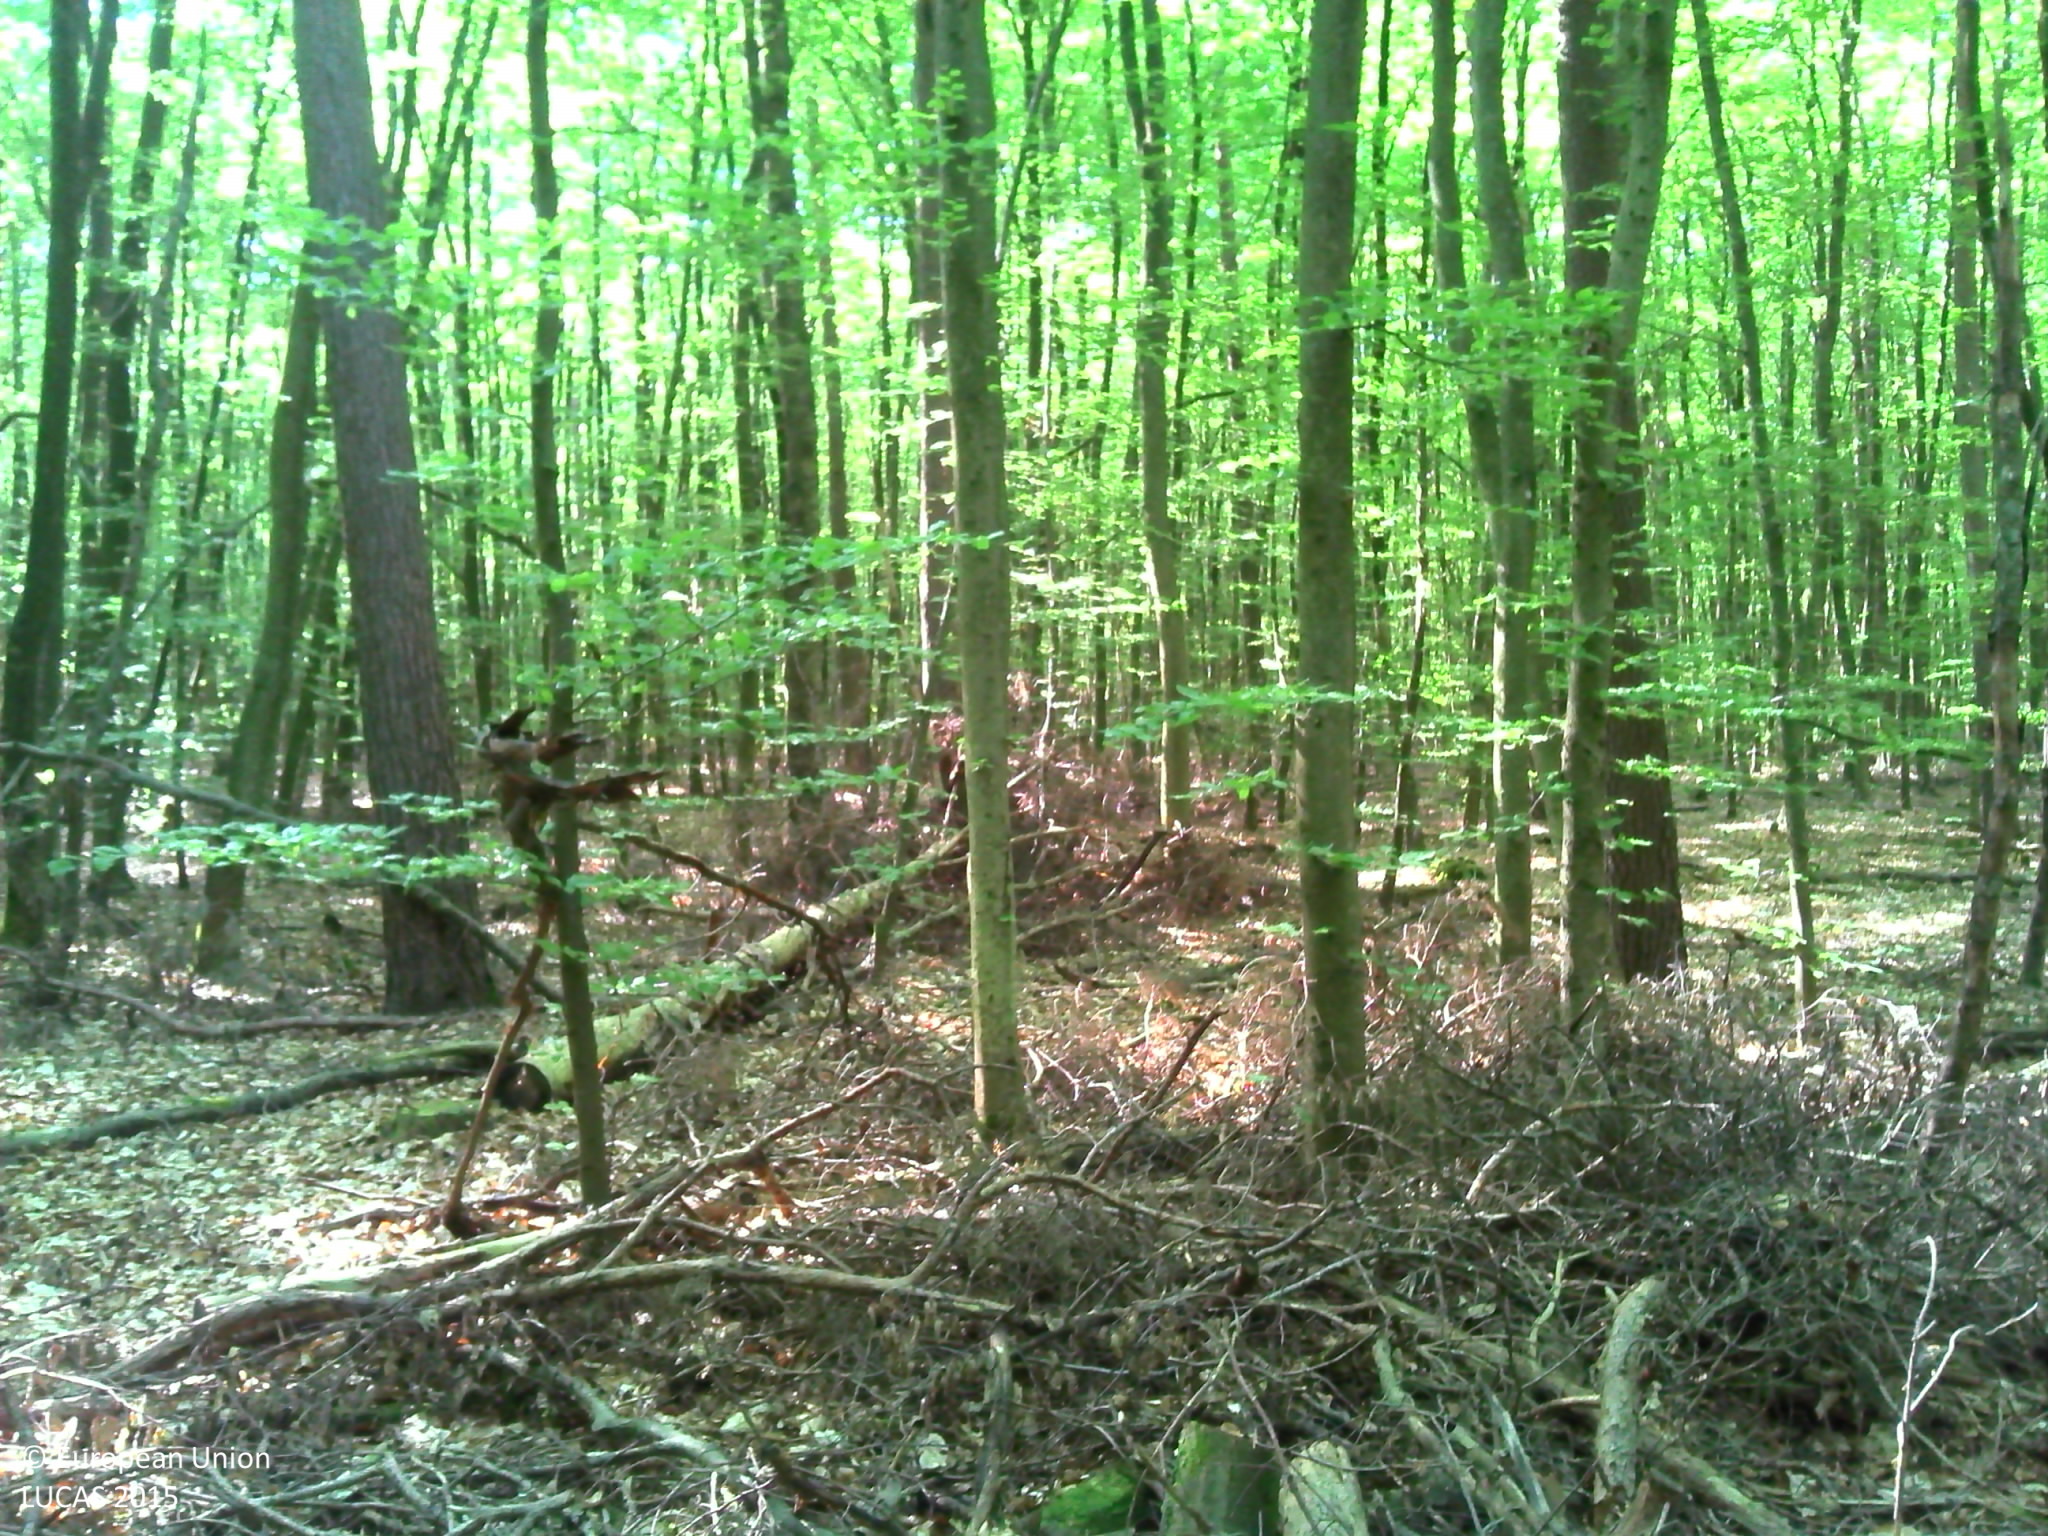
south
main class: Woodland
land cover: Broadleaved woodland
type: beech forest
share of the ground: > 75 %
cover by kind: broadleaved forest trees 95 %, coniferous forest trees 5 %
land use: Forestry
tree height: > 5 m
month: May
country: LU
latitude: 49.7855
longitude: 6.4024
